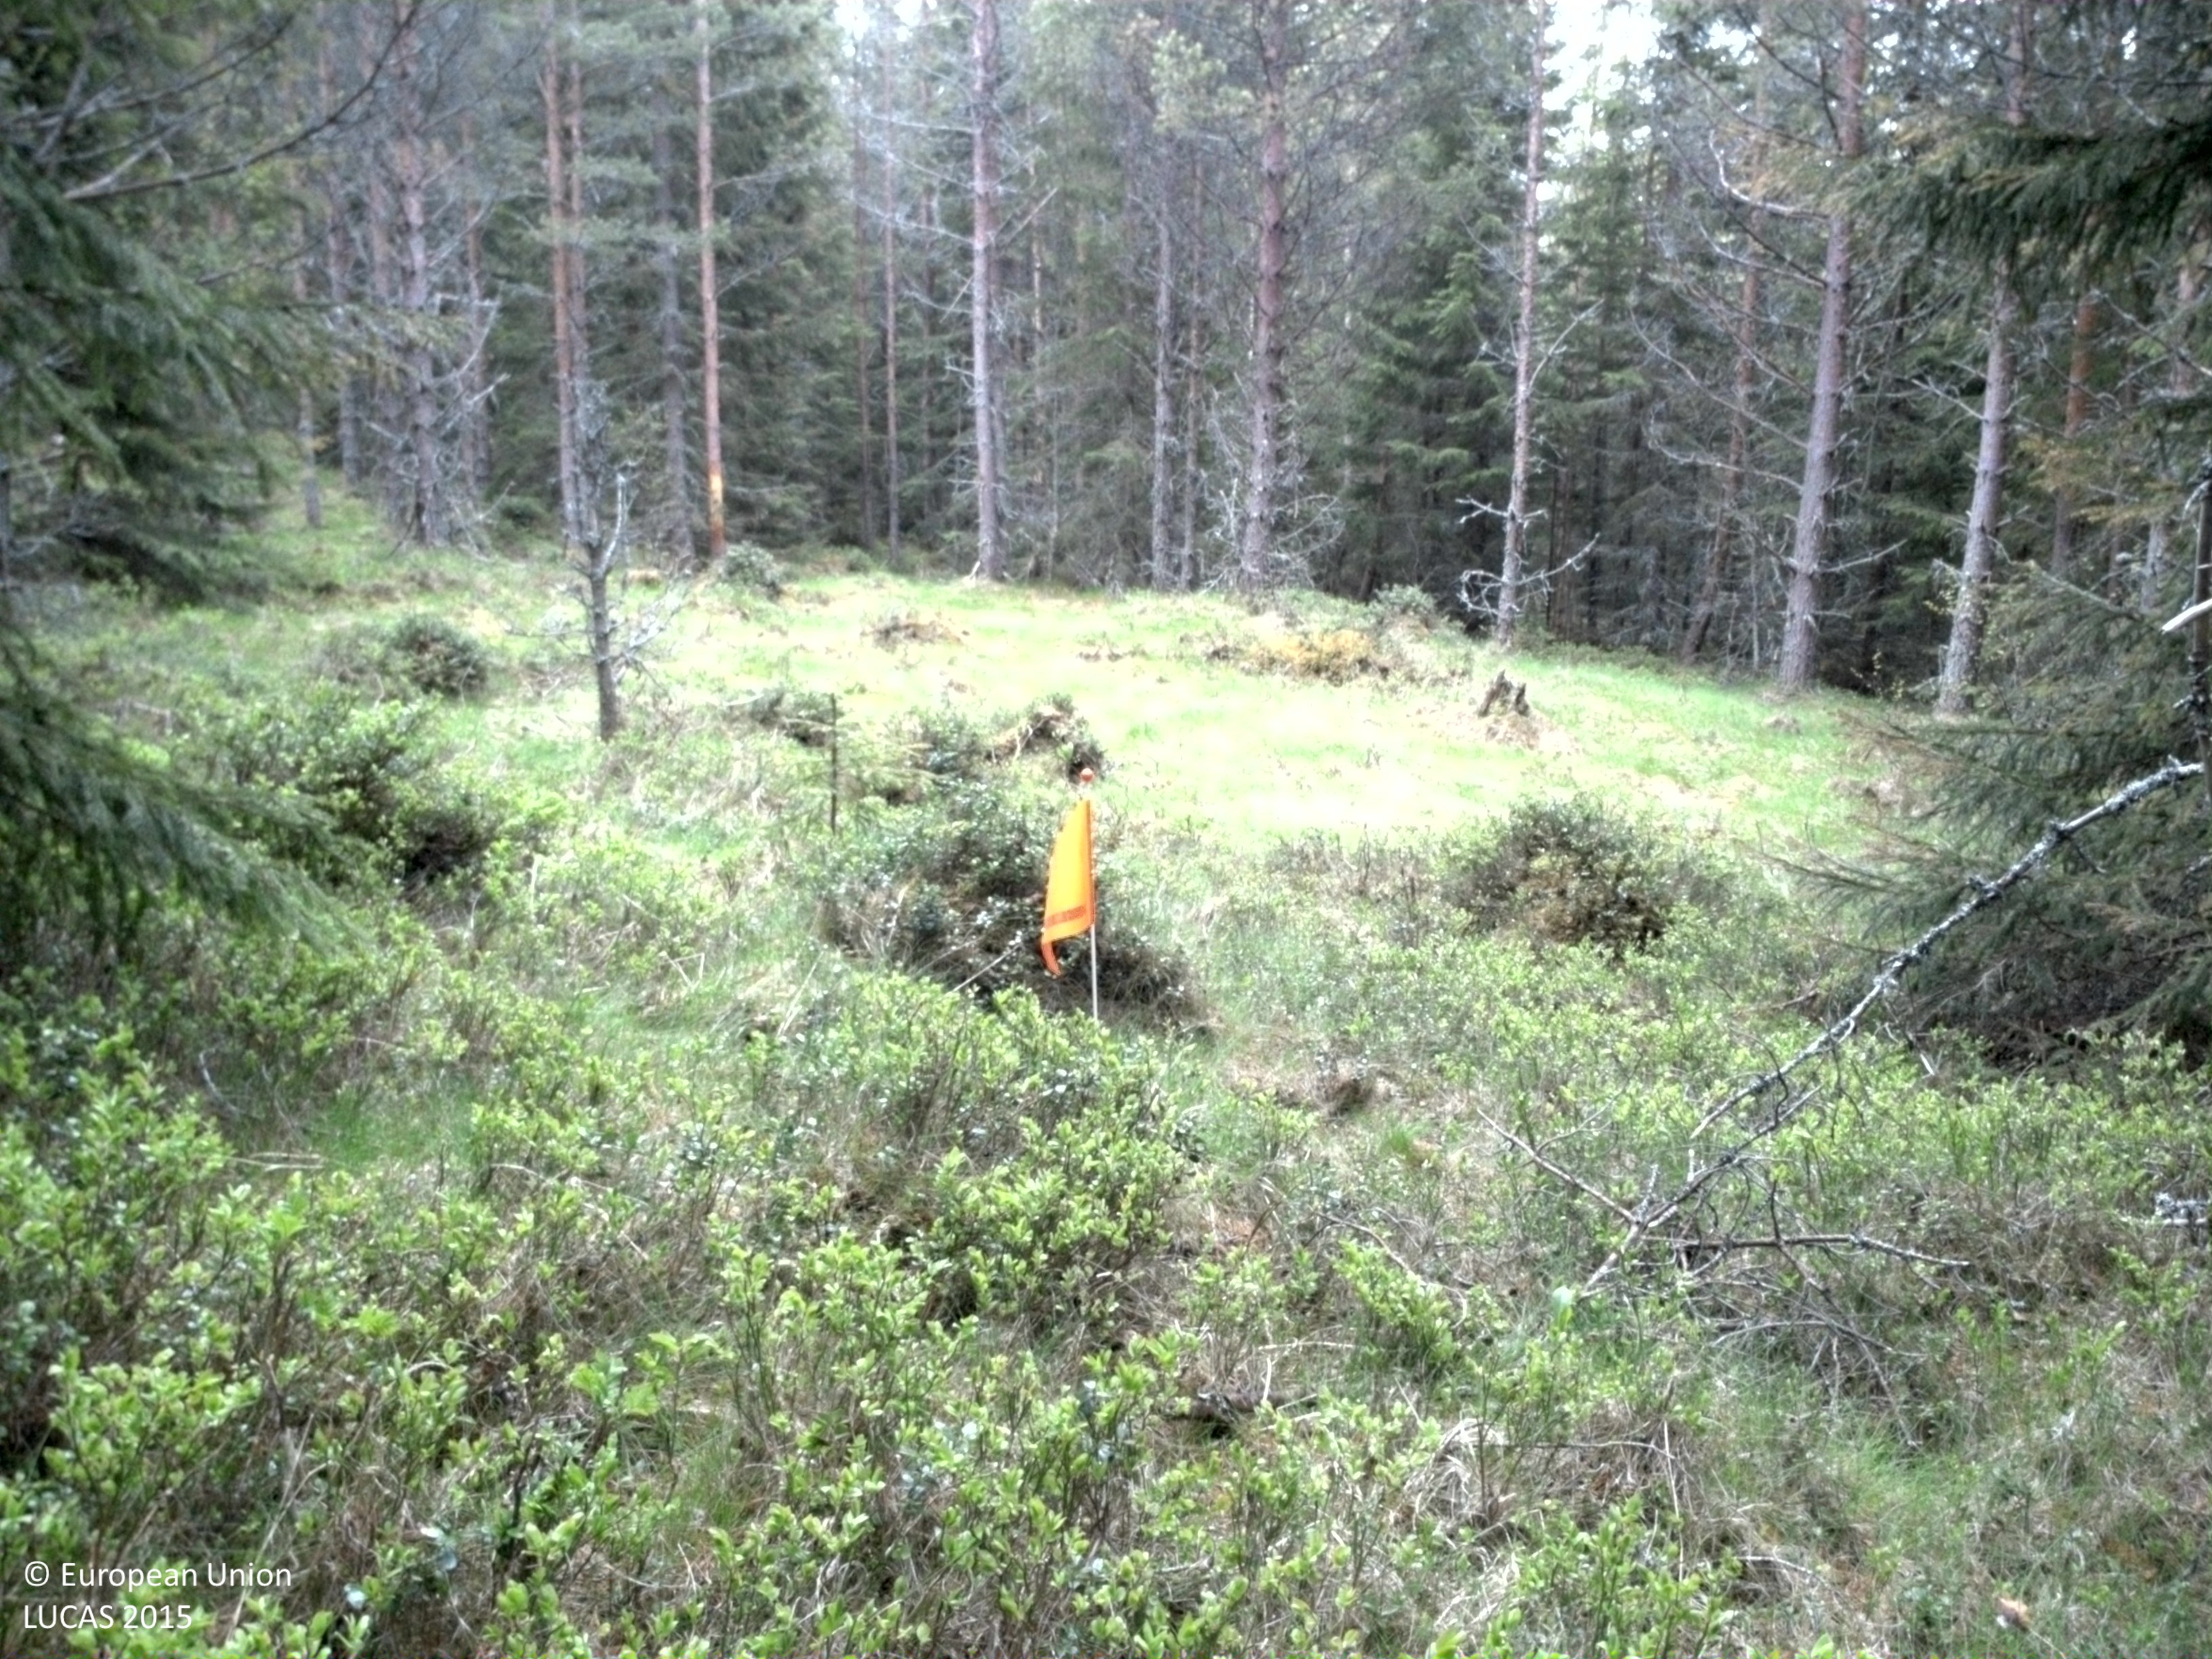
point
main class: Woodland
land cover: Pine dominated coniferous woodland
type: boreal forest
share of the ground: 25 - 50 %
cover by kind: herbaceous plants 65 %, coniferous forest trees 35 %
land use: Forestry
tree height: > 5 m
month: May
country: SE
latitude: 61.1801
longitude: 15.3595
